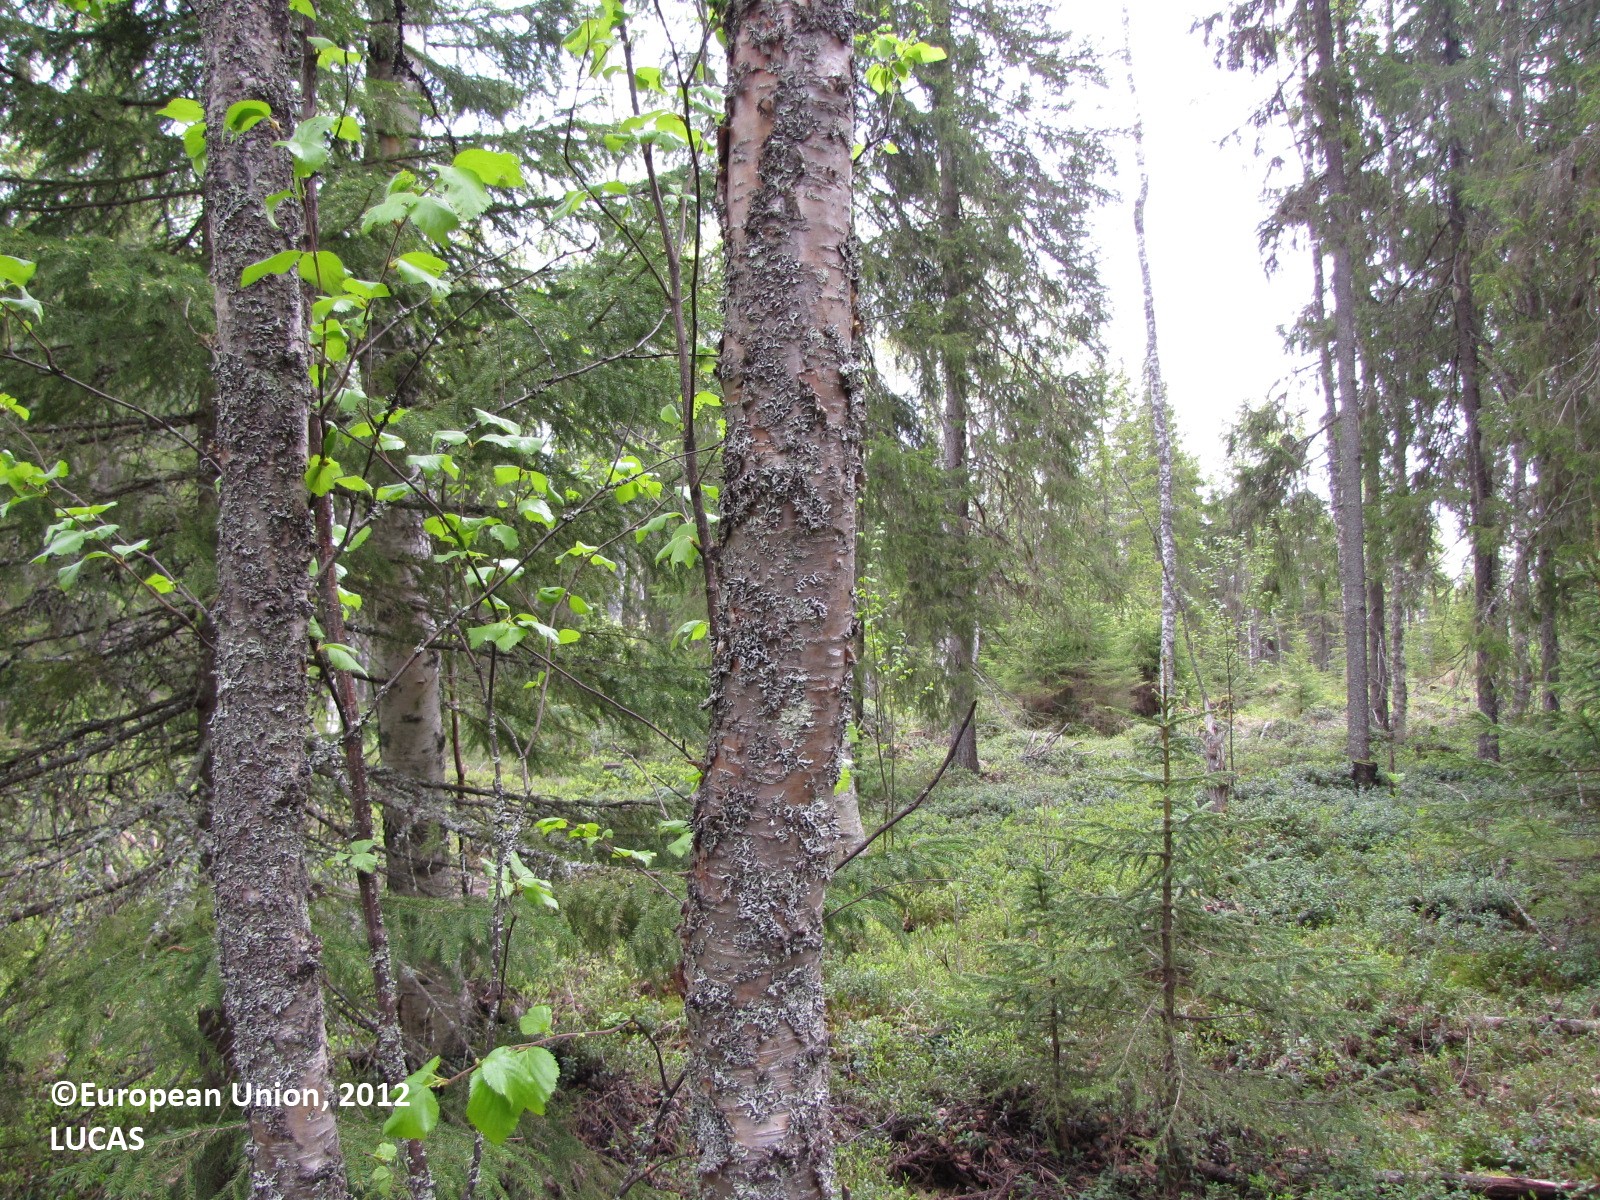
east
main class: Woodland
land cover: Spruce dominated mixed woodland
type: boreal forest
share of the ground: 50 - 75 %
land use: Forestry
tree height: > 5 m
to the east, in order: Spruce dominated mixed woodland; Ditches and canals; Spruce dominated mixed woodland; Ditches and canals; Tracks; Spruce dominated mixed woodland; Ditches and canals; Spruce dominated mixed woodland; Broadleaved woodland
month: June
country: FI
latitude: 65.8990
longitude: 24.5602
